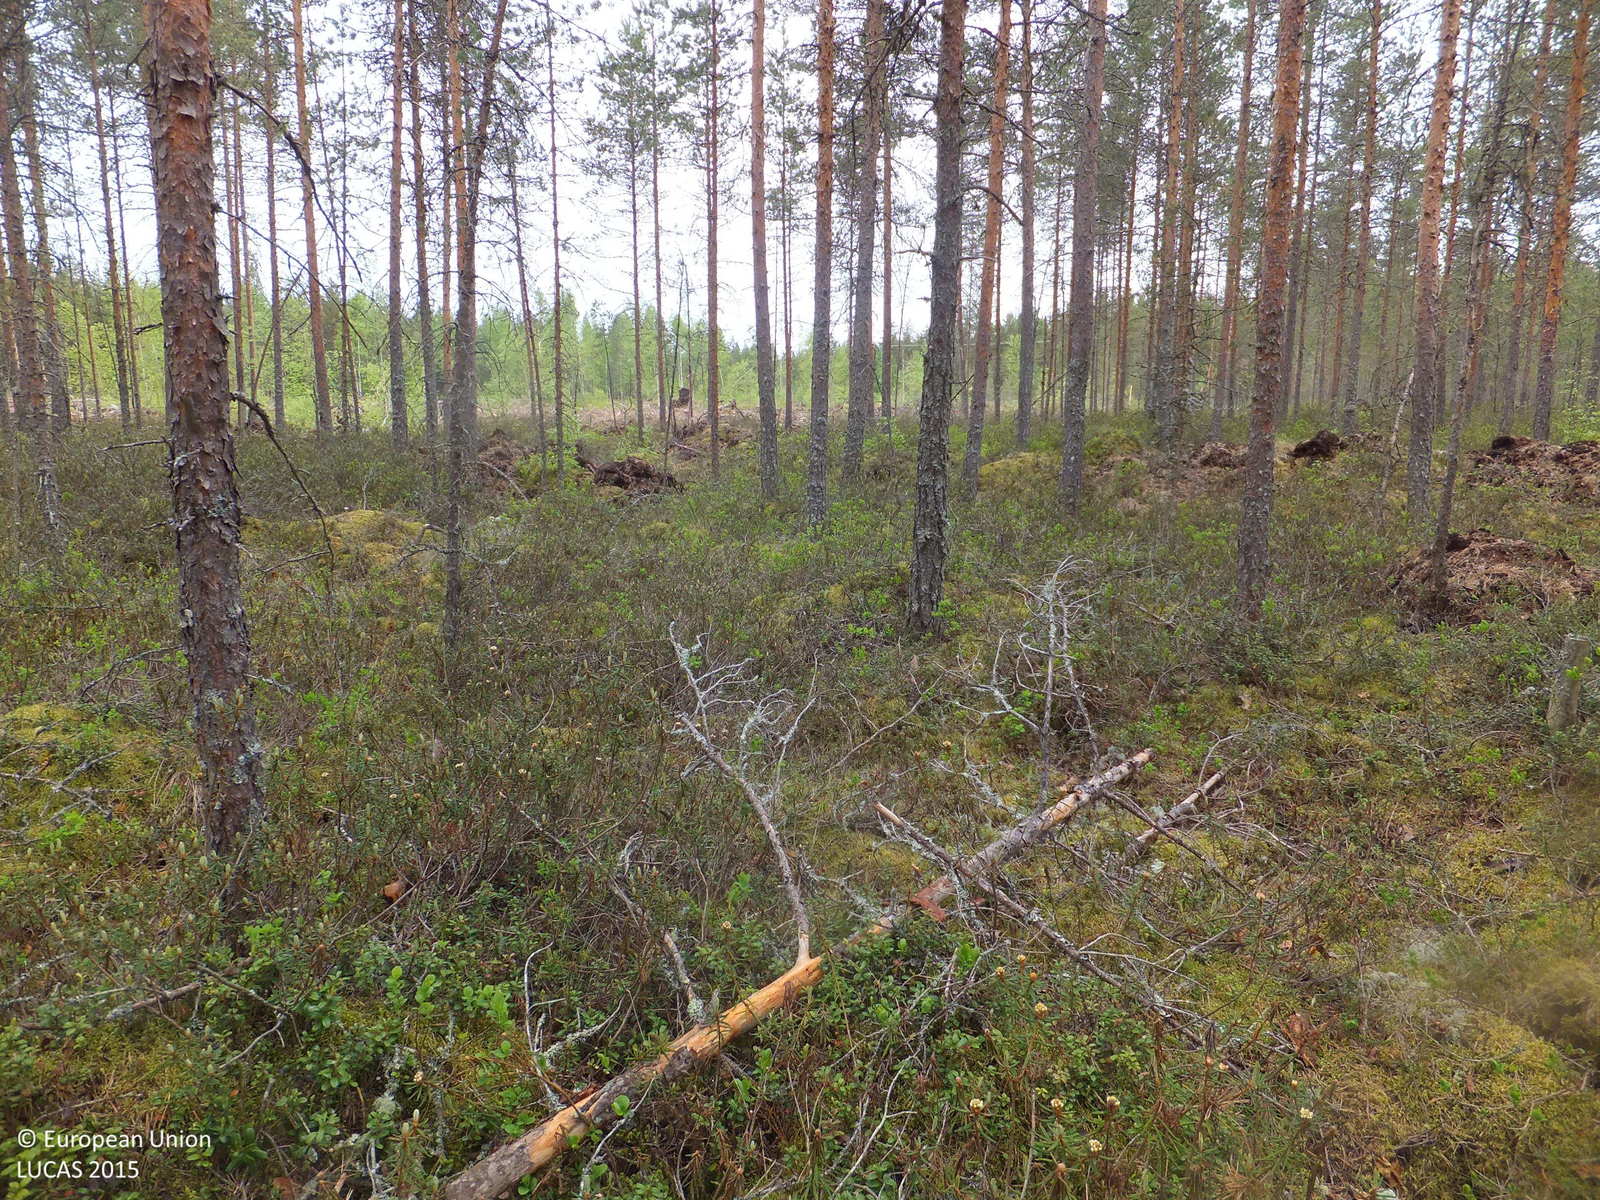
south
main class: Woodland
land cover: Pine dominated coniferous woodland
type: boreal forest
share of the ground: > 75 %
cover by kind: coniferous forest trees 80 %, shrubs 10 %, lichens and mosses 10 %
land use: Forestry
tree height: > 5 m
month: June
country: FI
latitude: 63.2589
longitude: 22.7418
